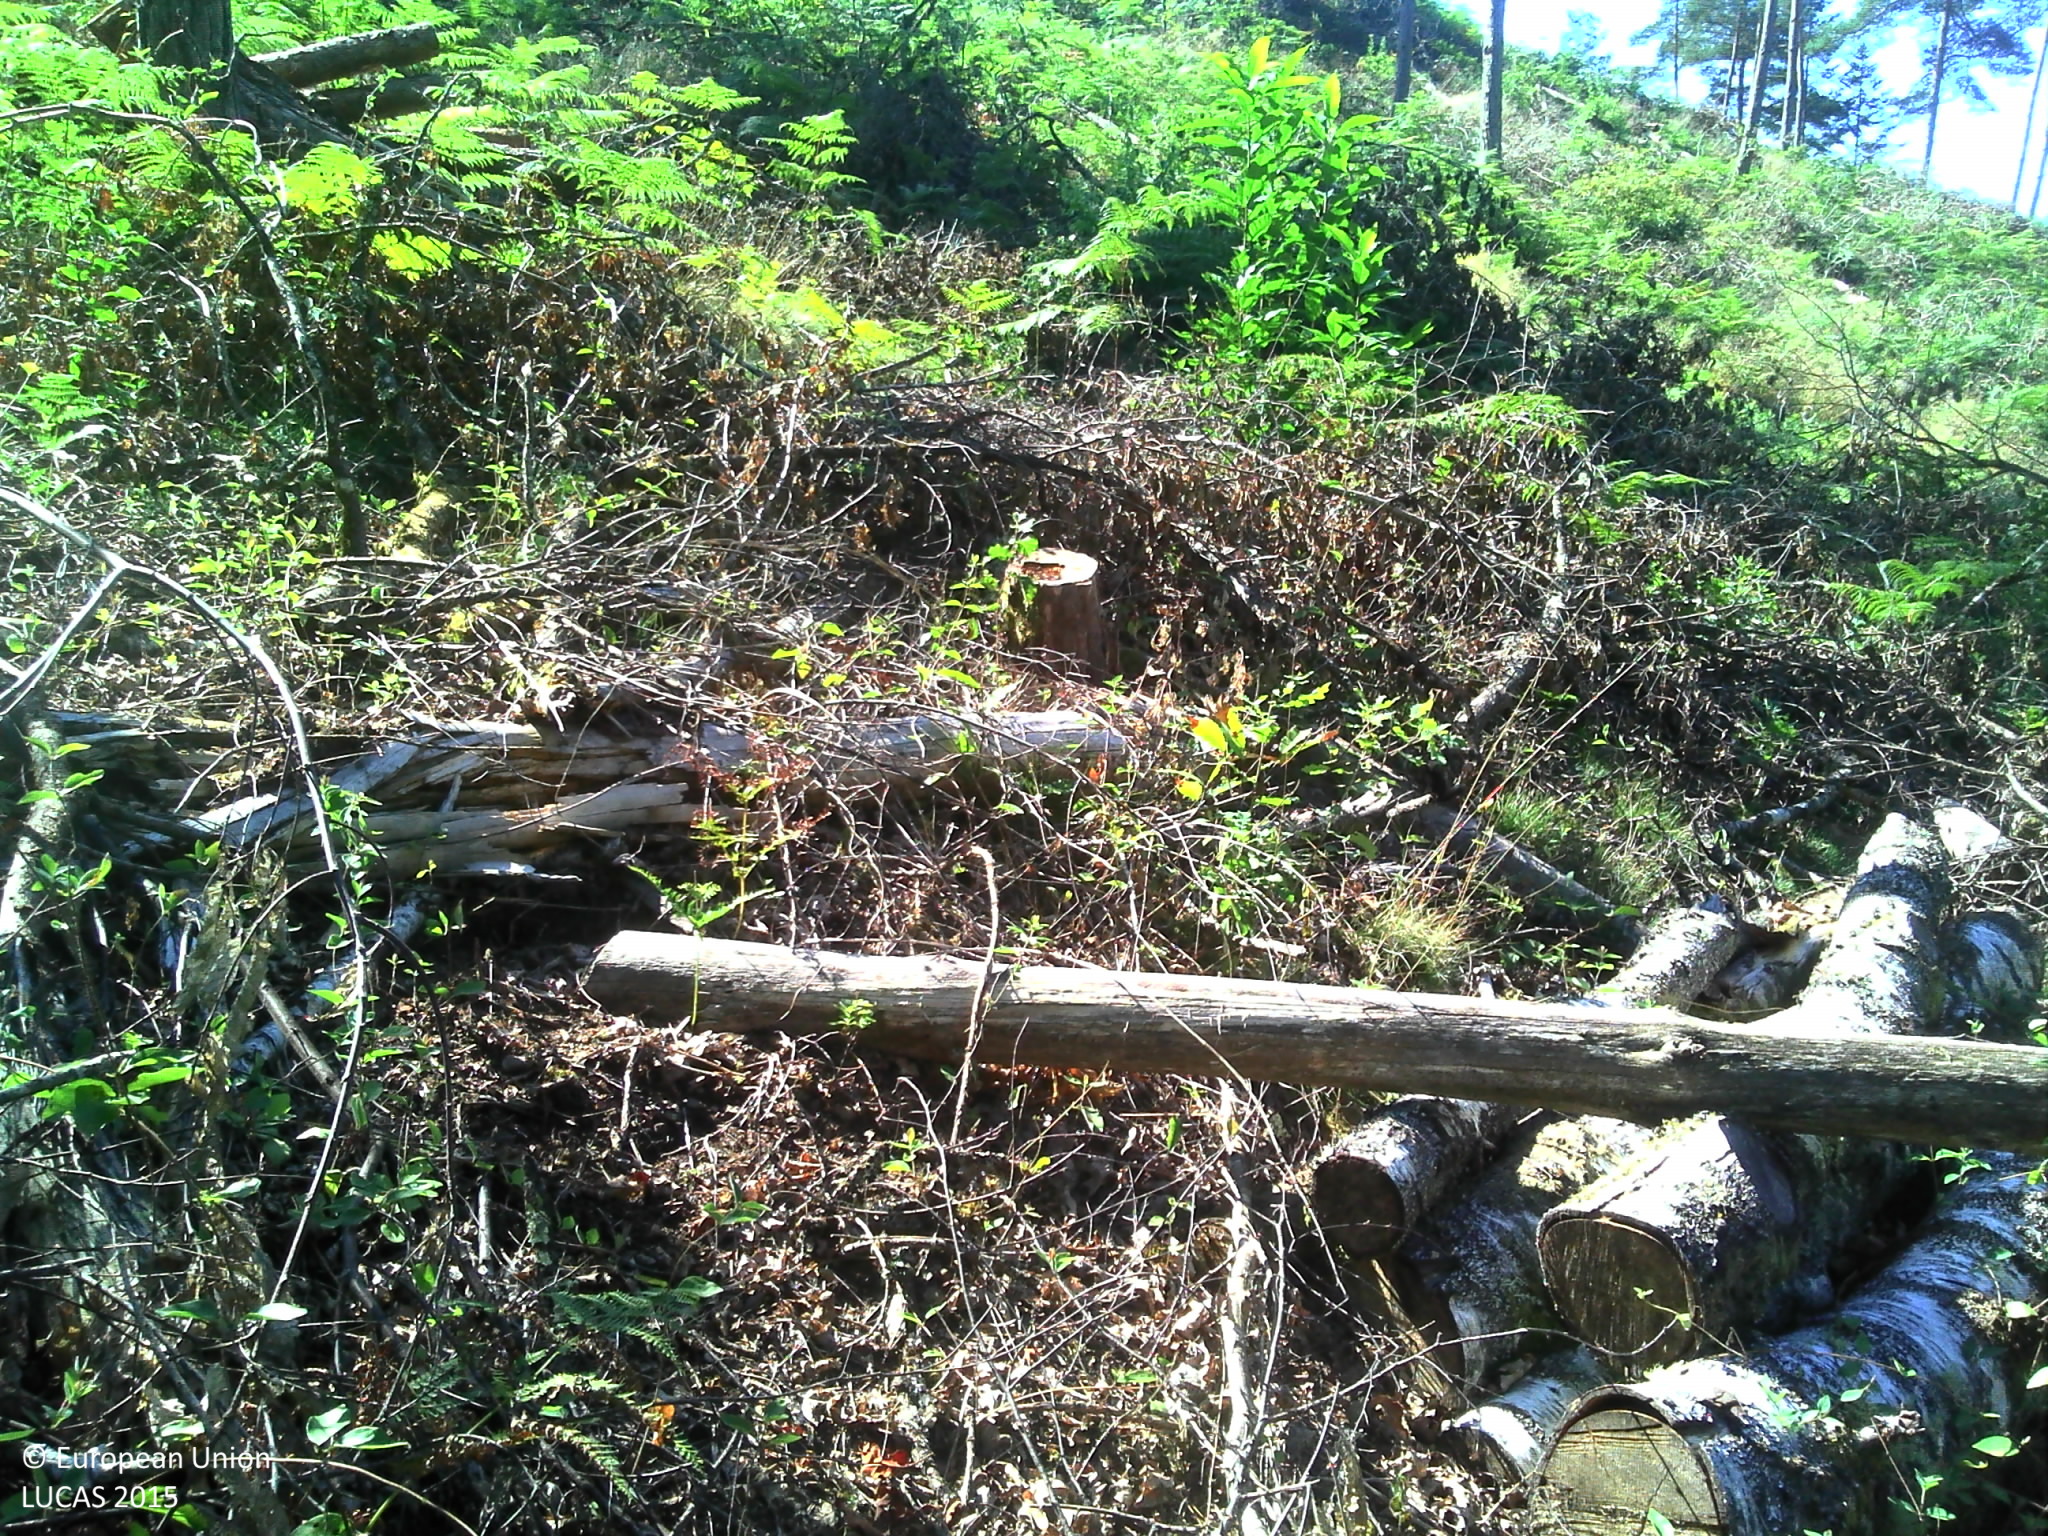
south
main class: Grassland
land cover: Spontaneously vegetated surfaces
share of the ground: > 75 %
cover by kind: herbaceous plants 95 %, shrubs 5 %
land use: Forestry
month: August
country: FR
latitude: 45.8795
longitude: 1.4234
